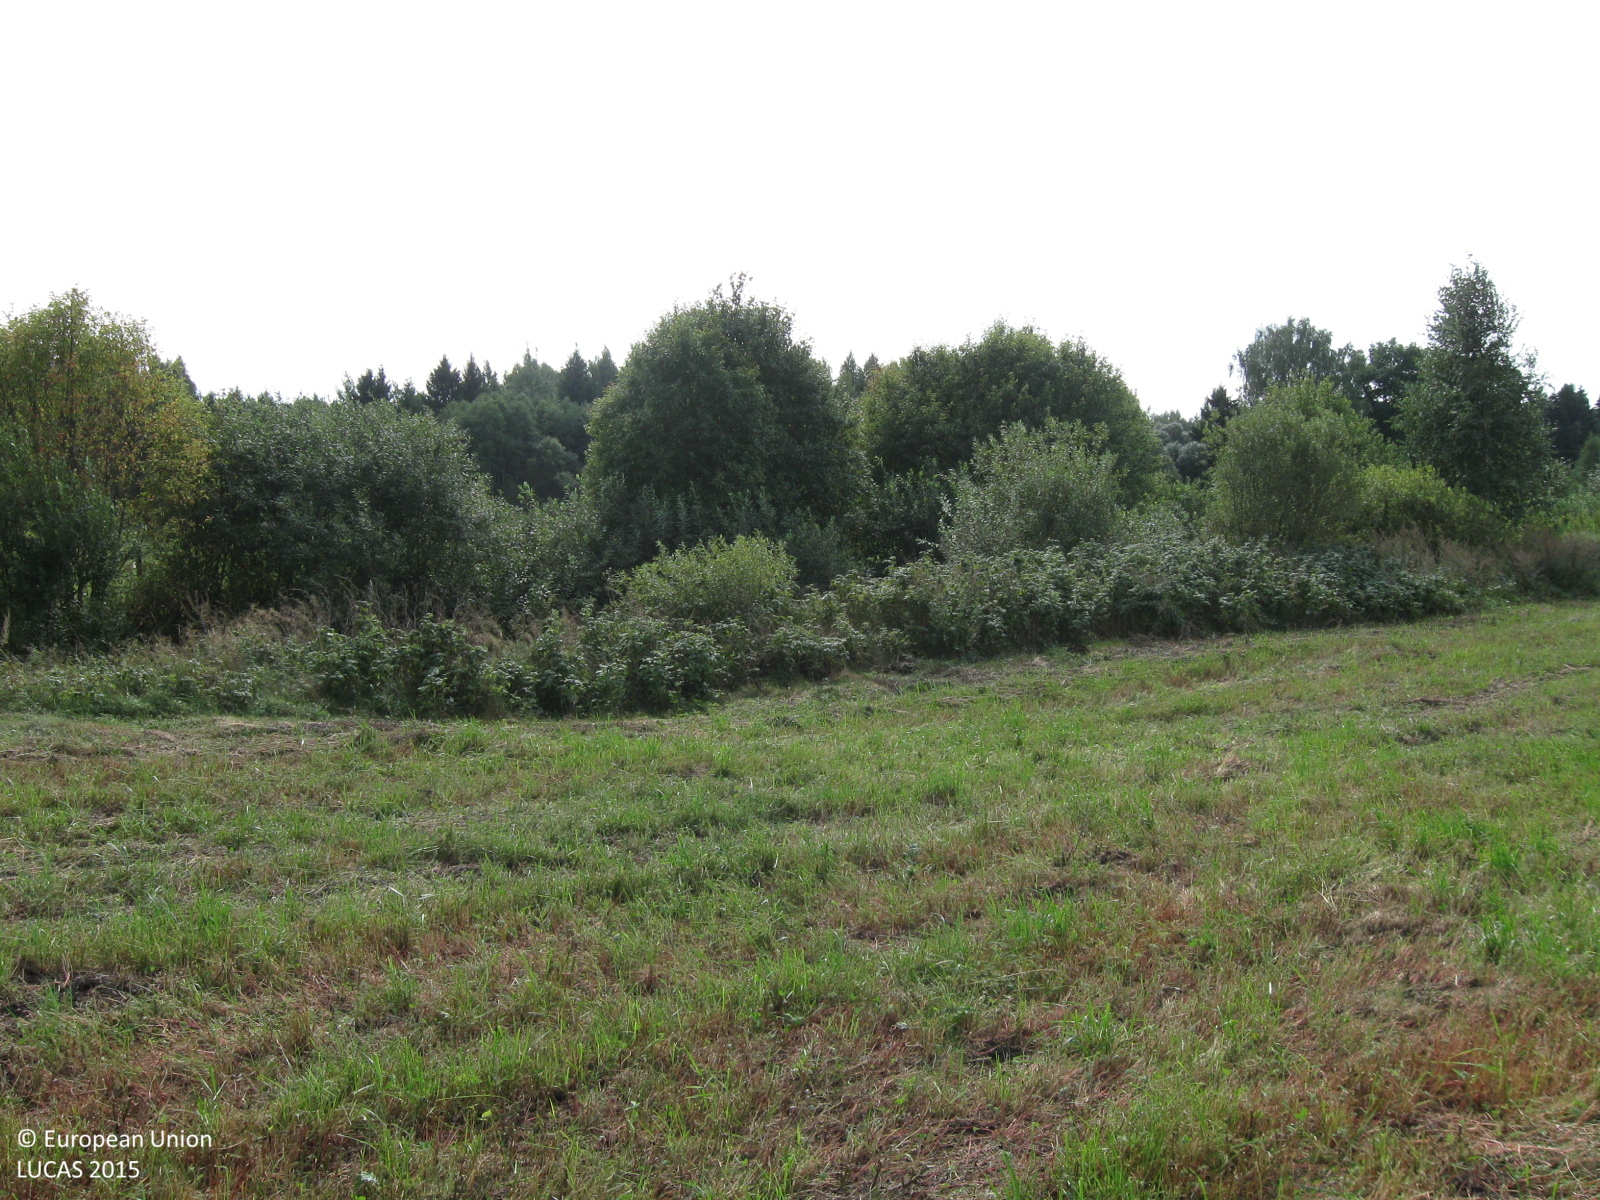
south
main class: Grassland
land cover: Grassland without tree/shrub cover
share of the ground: > 75 %
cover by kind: herbaceous plants 90 %, unconsolidated bare surface 10 %
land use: Agriculture (excluding fallow land and kitchen gardens)
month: August
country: LT
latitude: 55.5693
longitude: 23.2526
